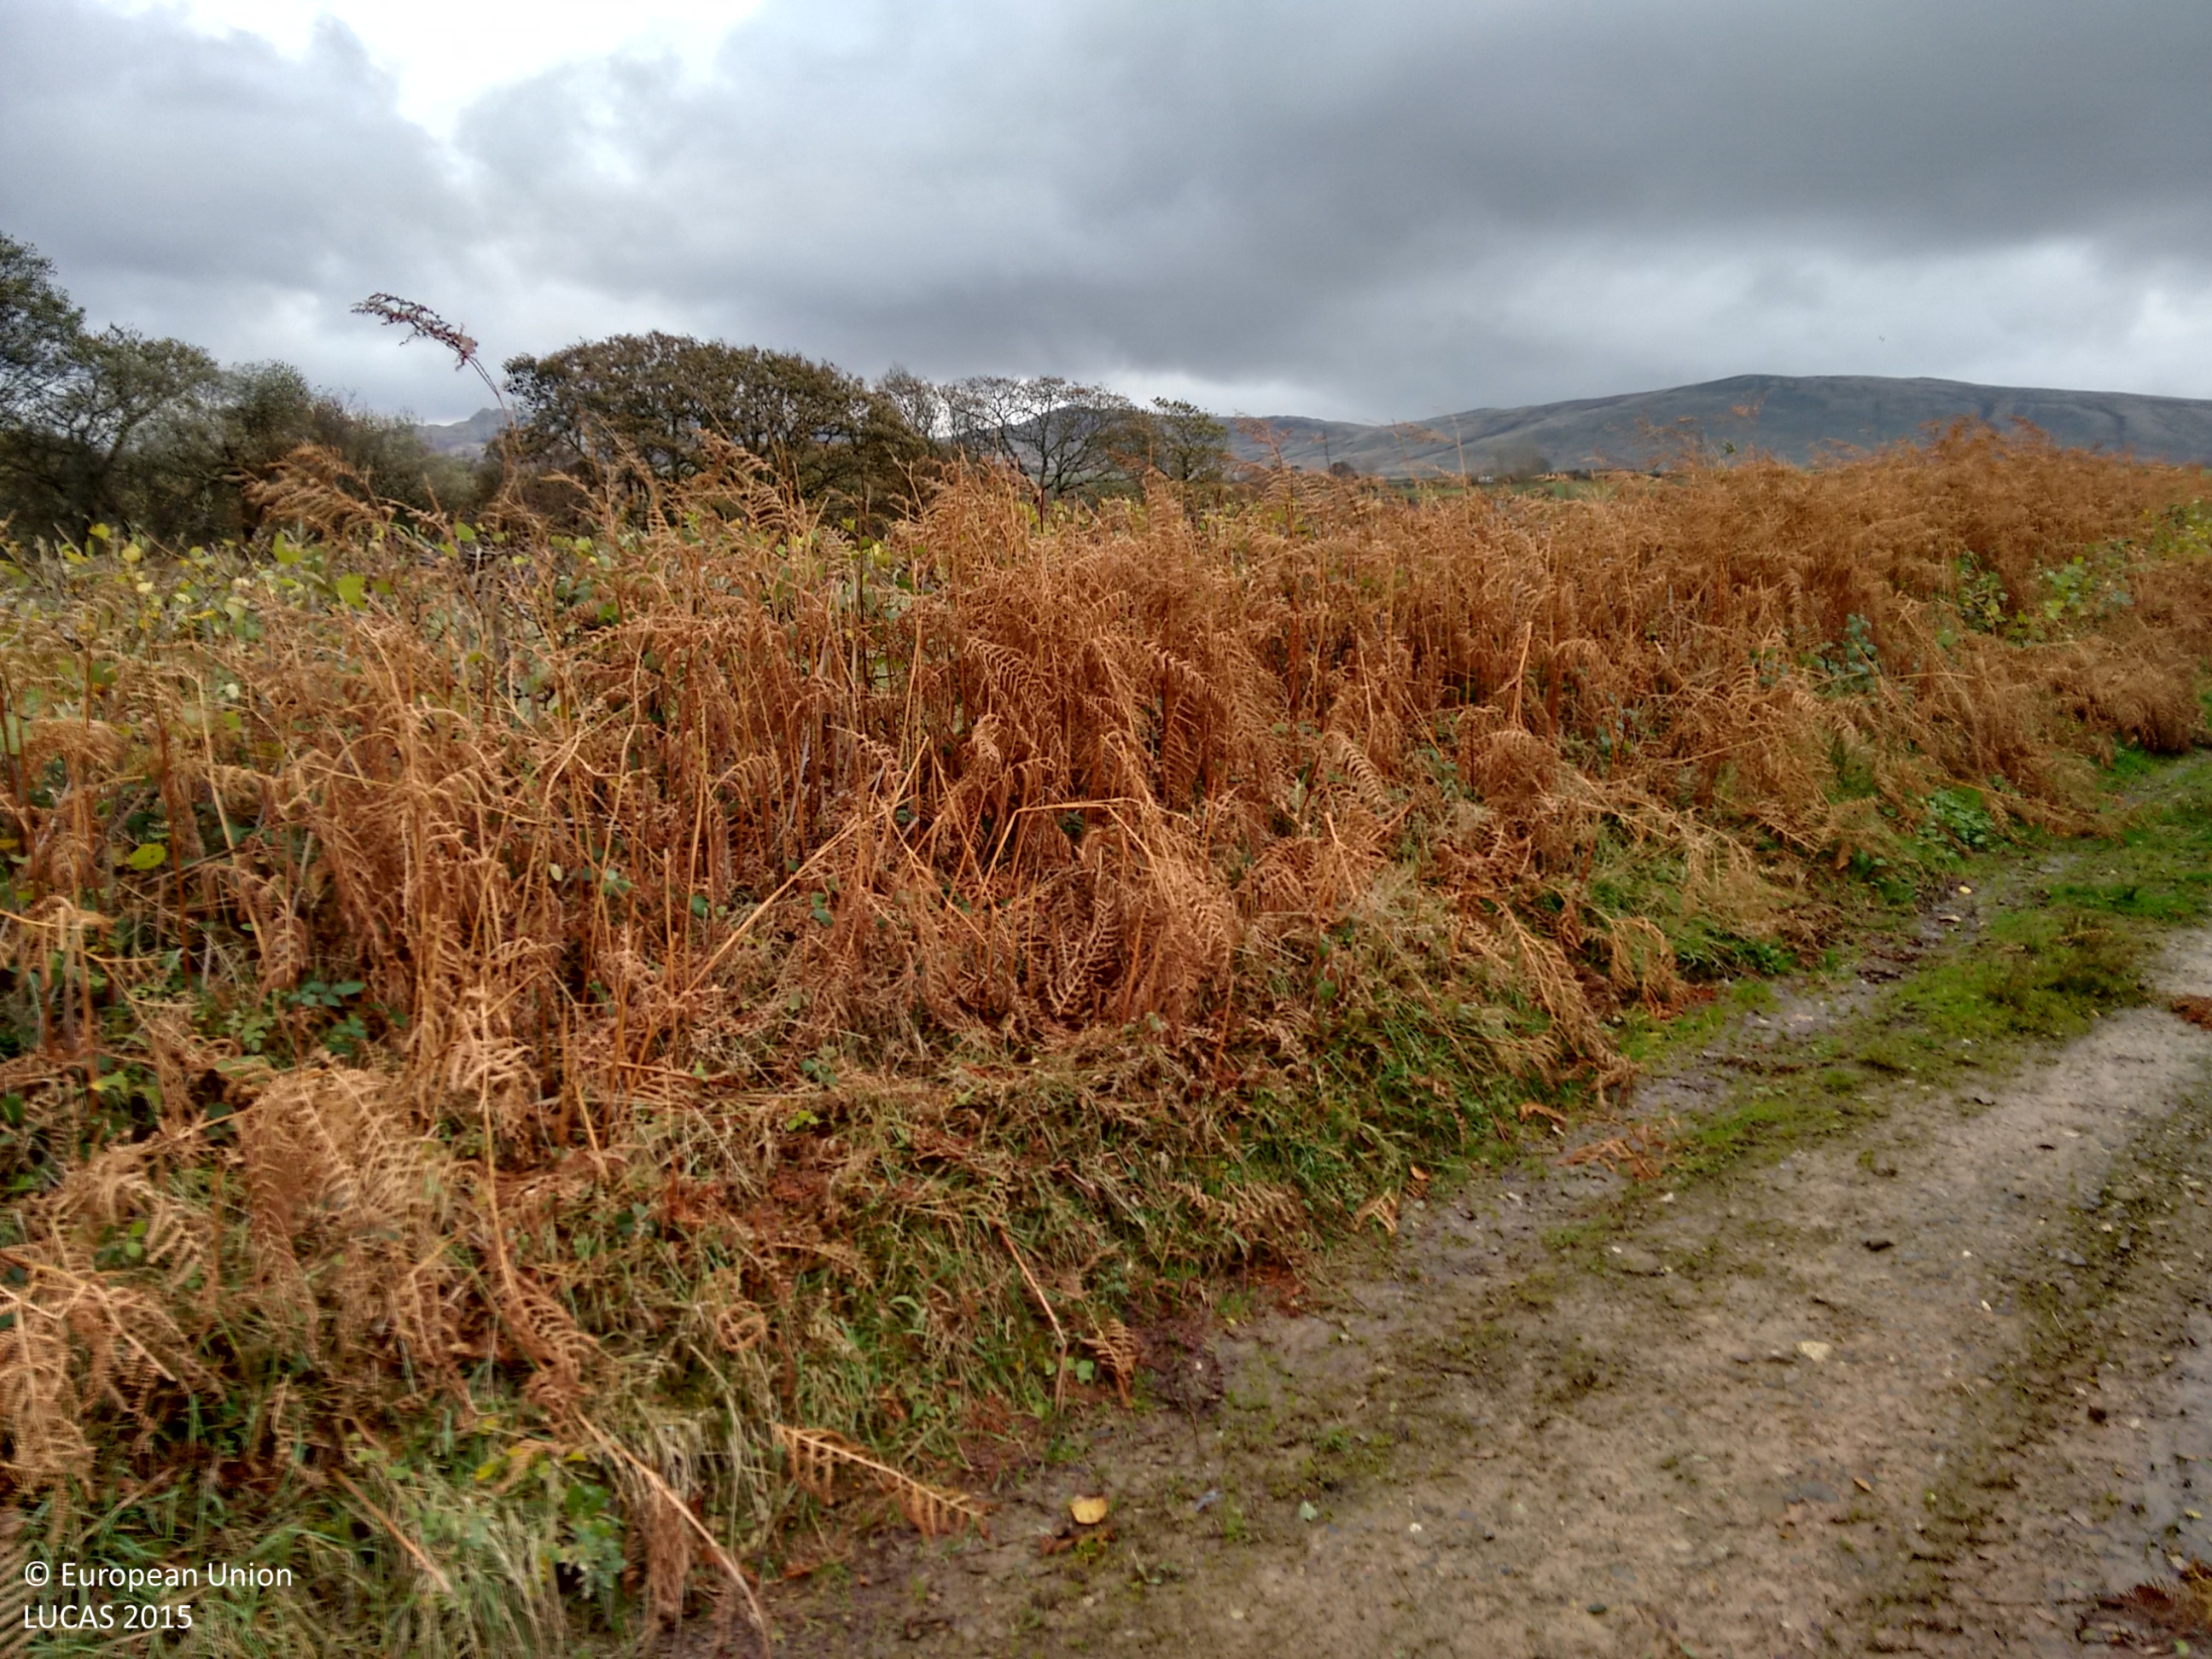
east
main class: Grassland
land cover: Grassland without tree/shrub cover
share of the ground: > 75 %
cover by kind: herbaceous plants 100 %
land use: Agriculture (excluding fallow land and kitchen gardens)
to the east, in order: Grassland without tree/shrub cover; Fences; Managed hedges; Grass margins; Tracks; Grass margins; Managed hedges; Fences; Grassland without tree/shrub cover; Fences; Managed hedges; Grassland without tree/shrub cover; Fences; Managed hedges; Artificial constructions in urban areas; Broadleaved woodland
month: November
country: GB
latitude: 54.3329
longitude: -3.3825
